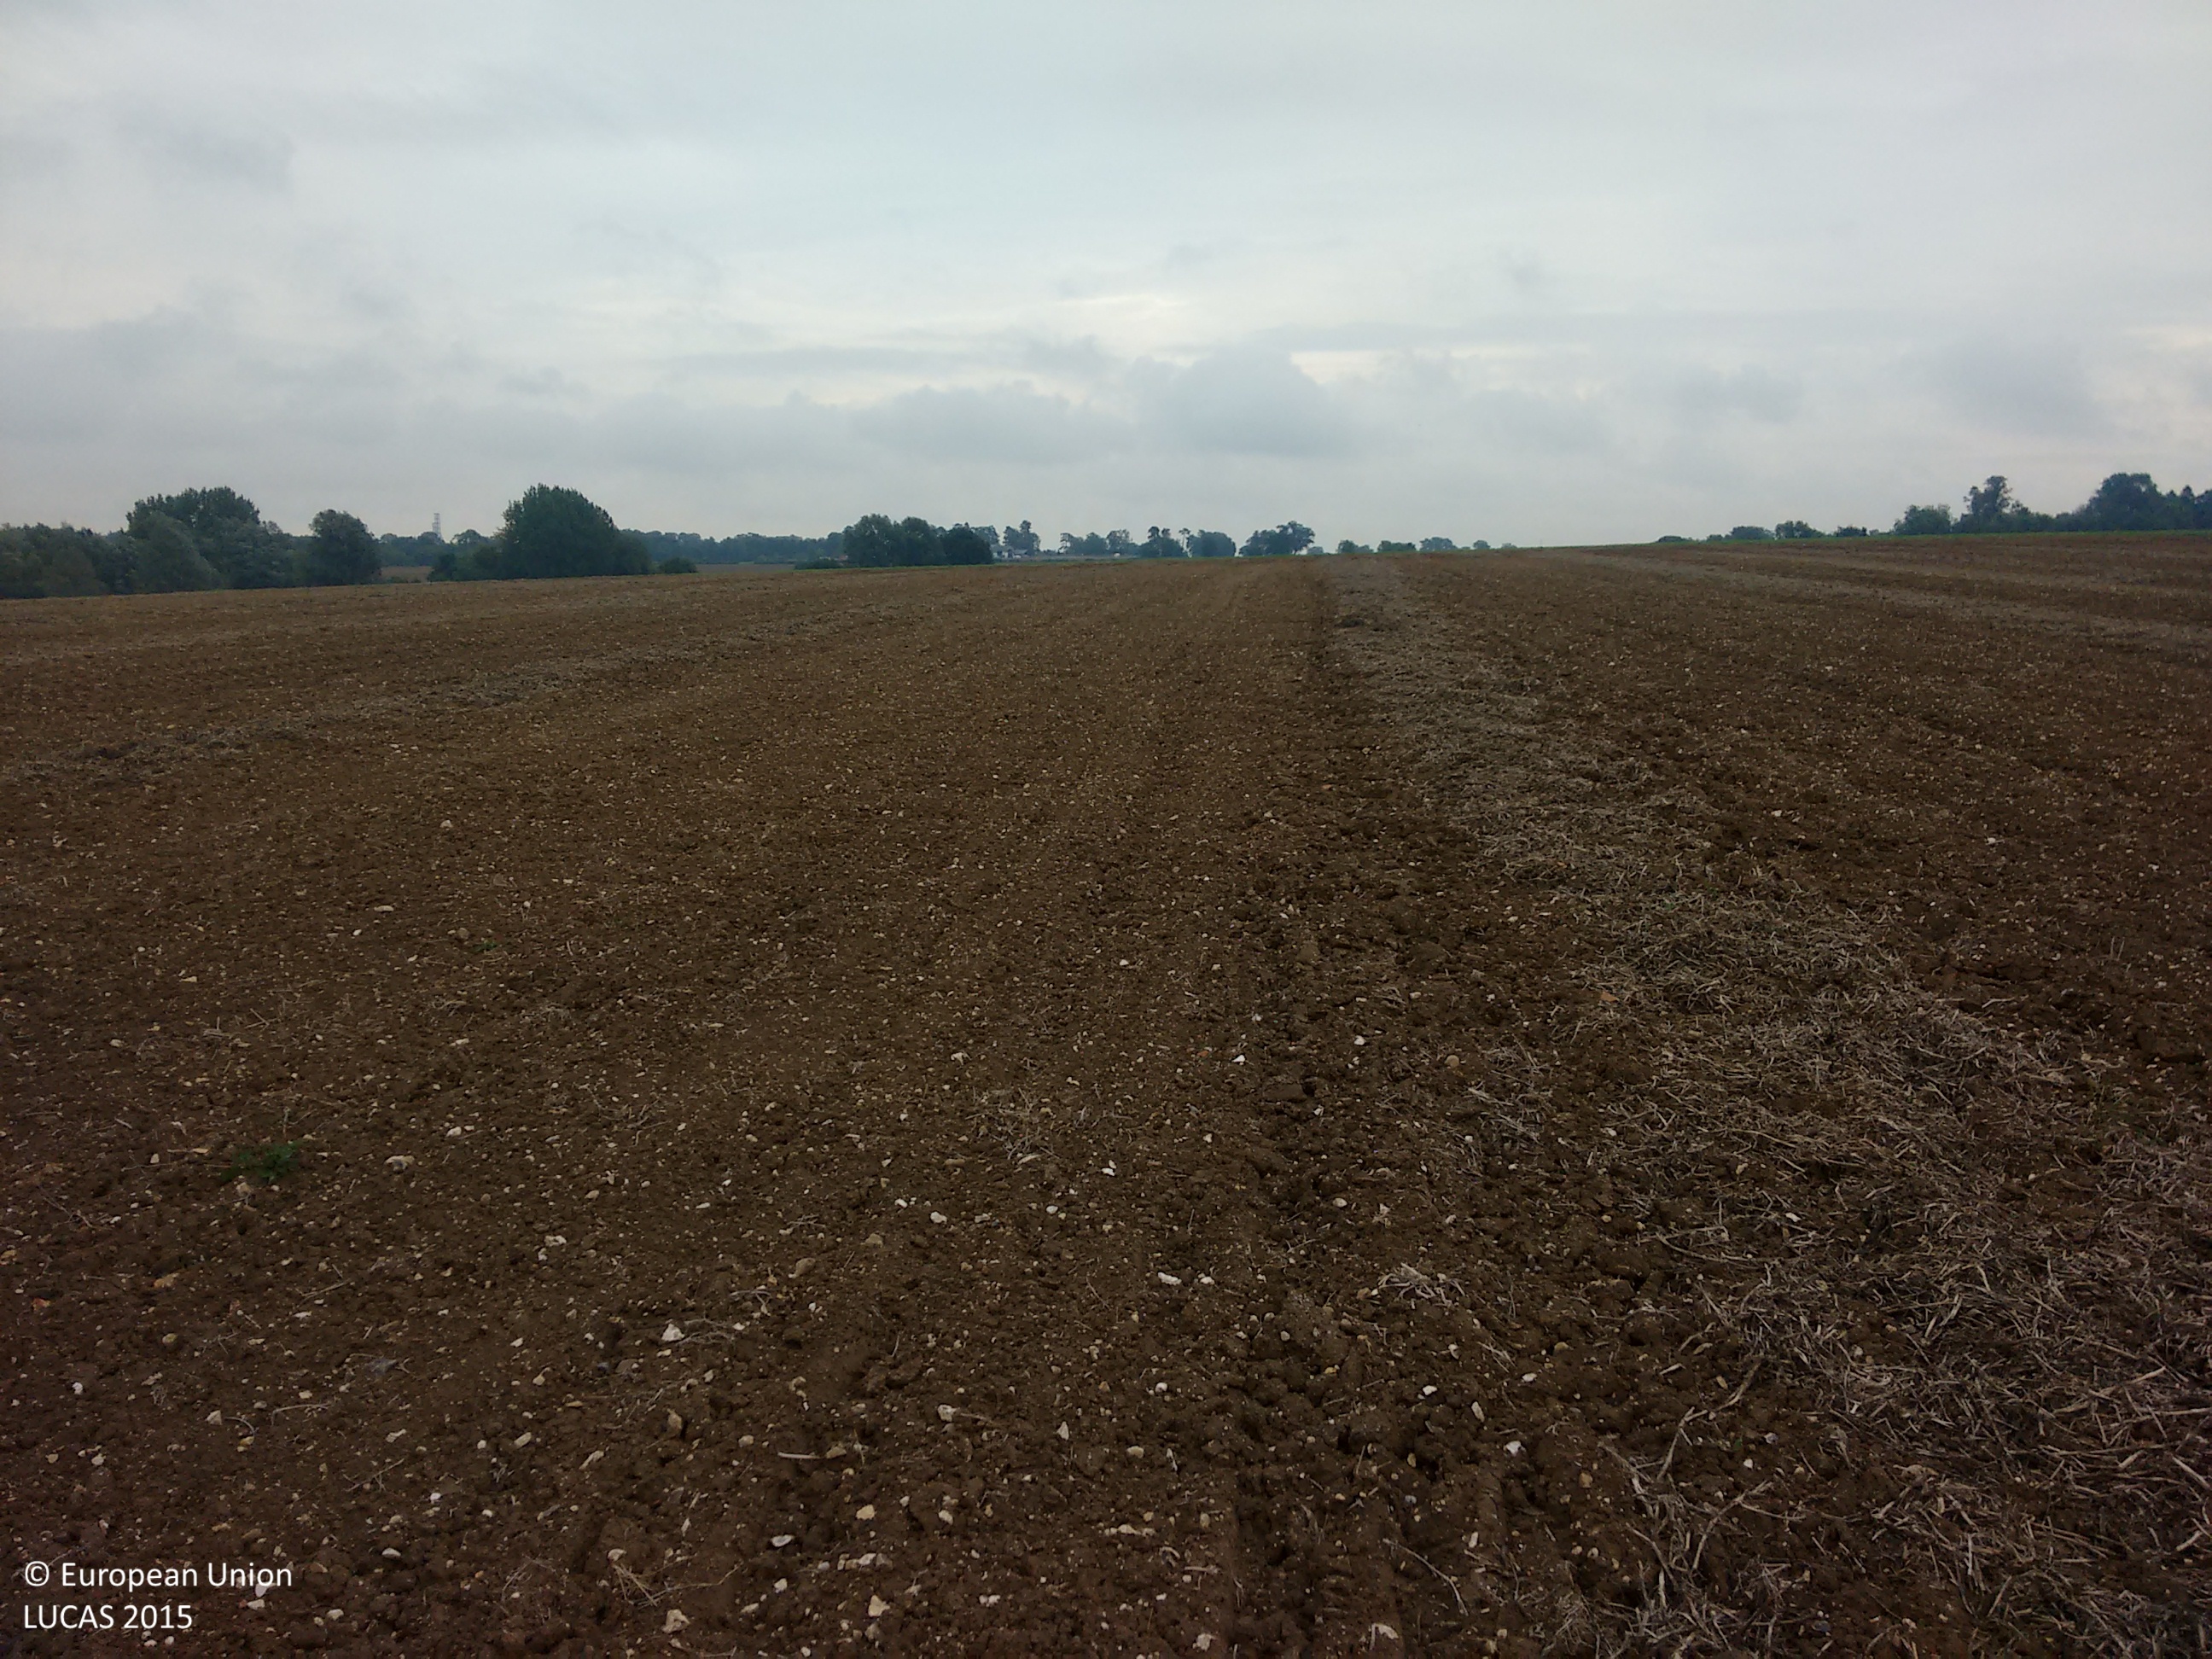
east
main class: Cropland
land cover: Dry pulses
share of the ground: < 10 %
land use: Agriculture (excluding fallow land and kitchen gardens)
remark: Harvested field
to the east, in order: Dry pulses; Grass margins; Tracks; Grass margins; Dry pulses
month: September
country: GB
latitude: 51.9381
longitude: 0.2386
